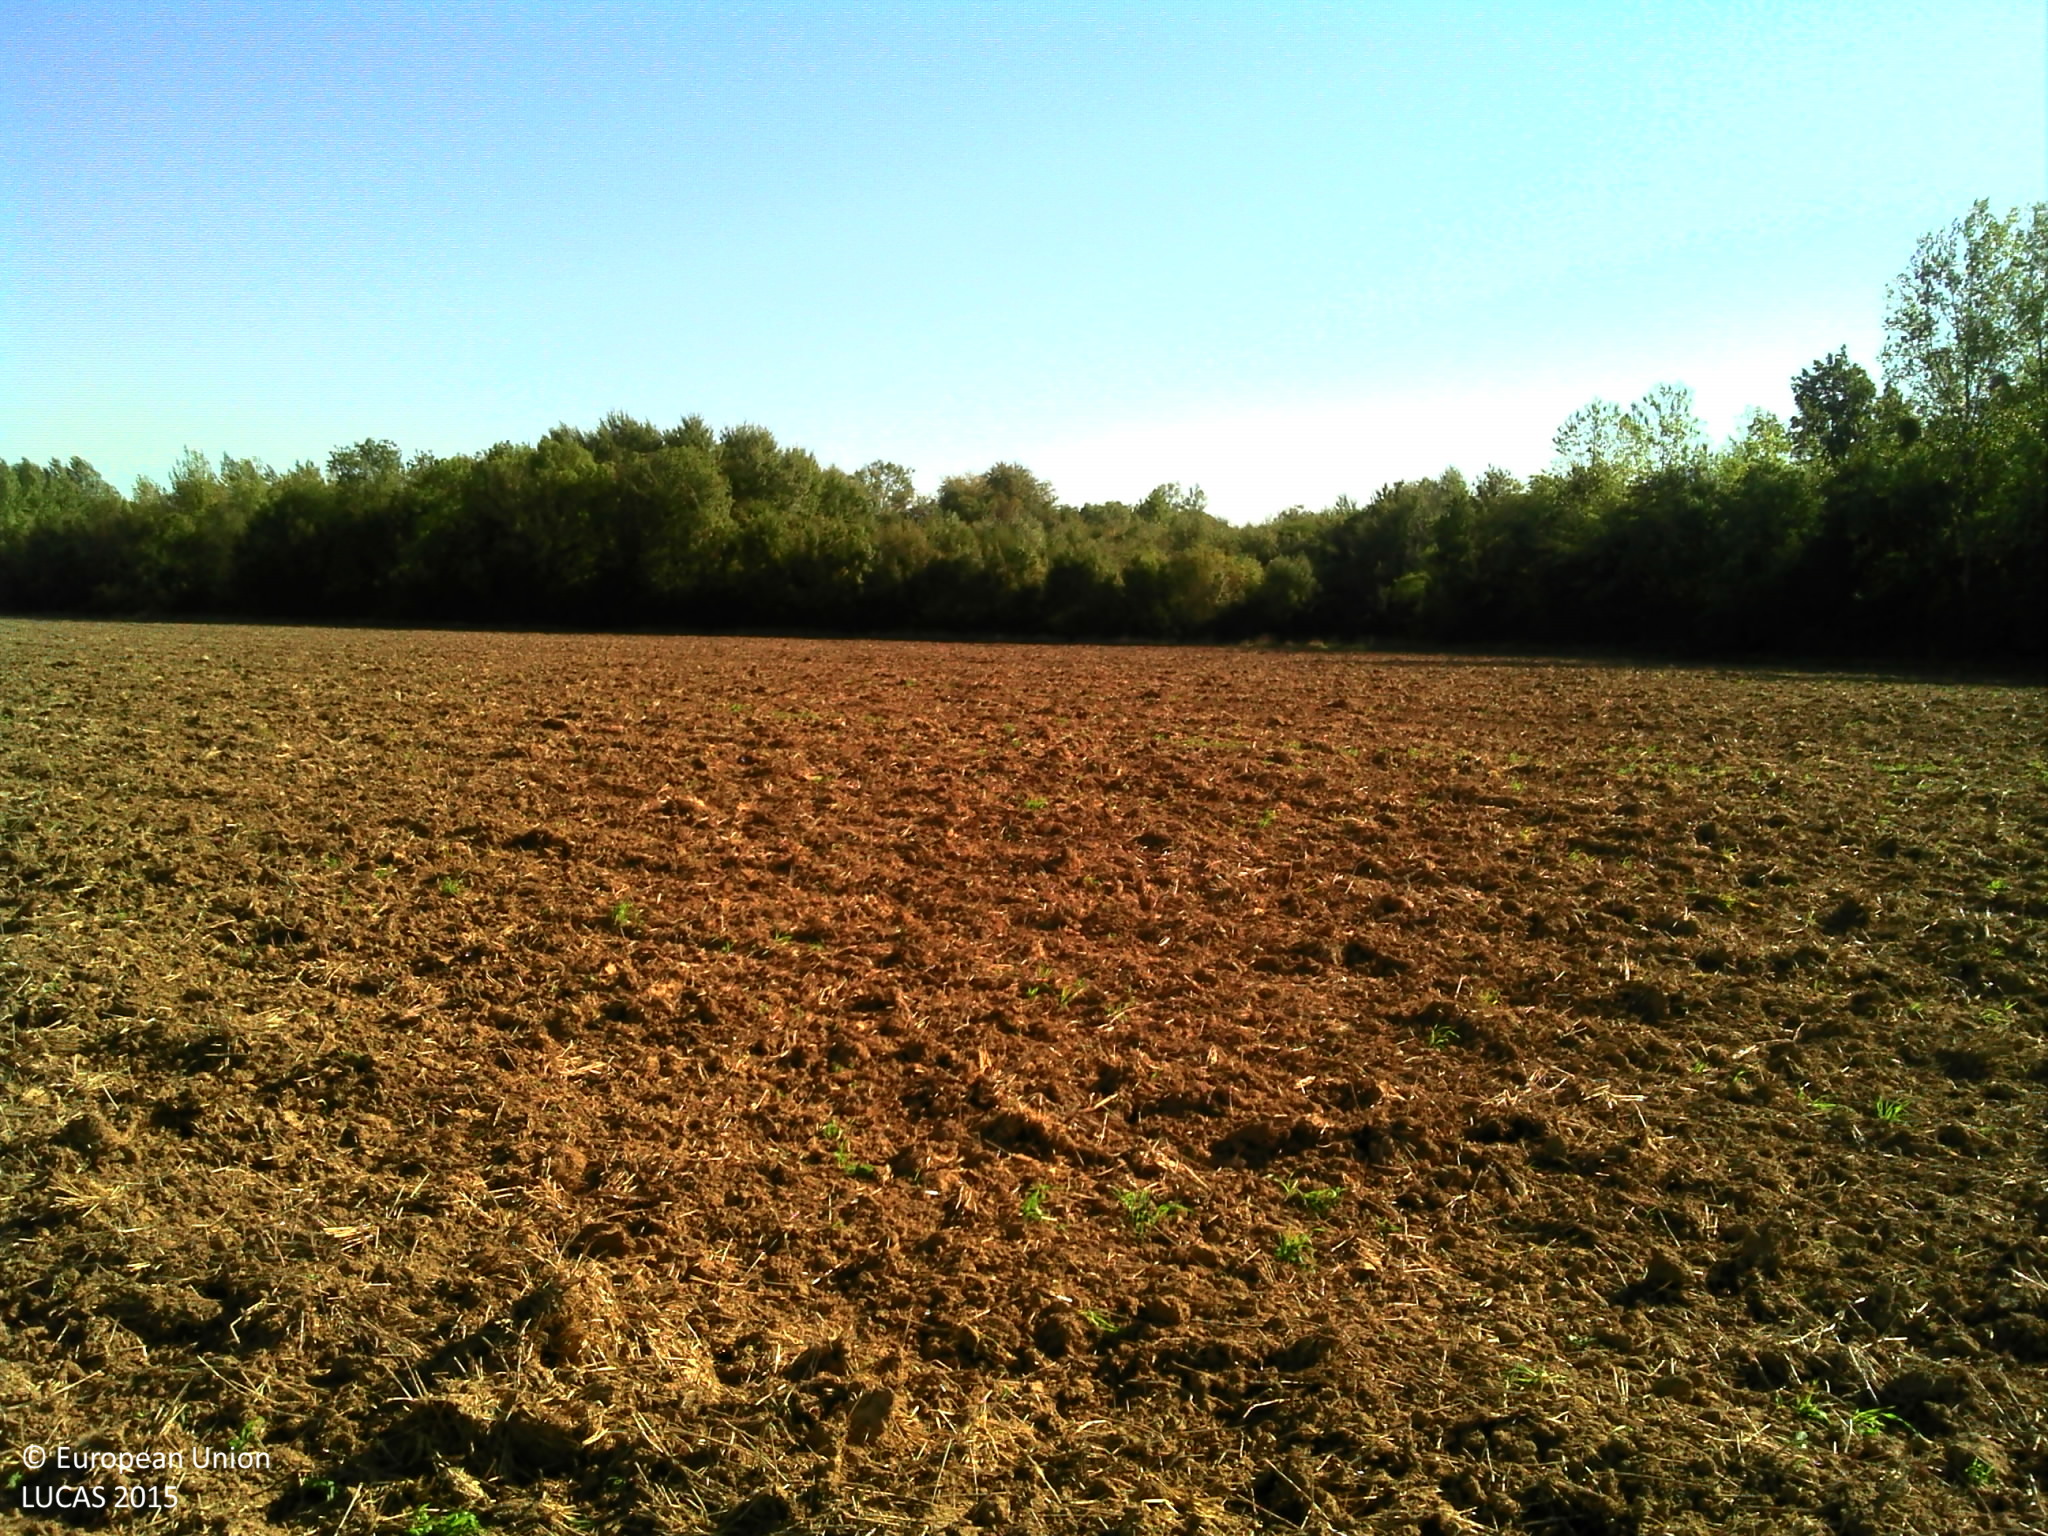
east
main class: Cropland
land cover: Common wheat
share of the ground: < 10 %
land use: Agriculture (excluding fallow land and kitchen gardens)
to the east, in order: Common wheat; Grass margins; Broadleaved woodland
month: September
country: FR
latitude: 48.4220
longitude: 3.3858
